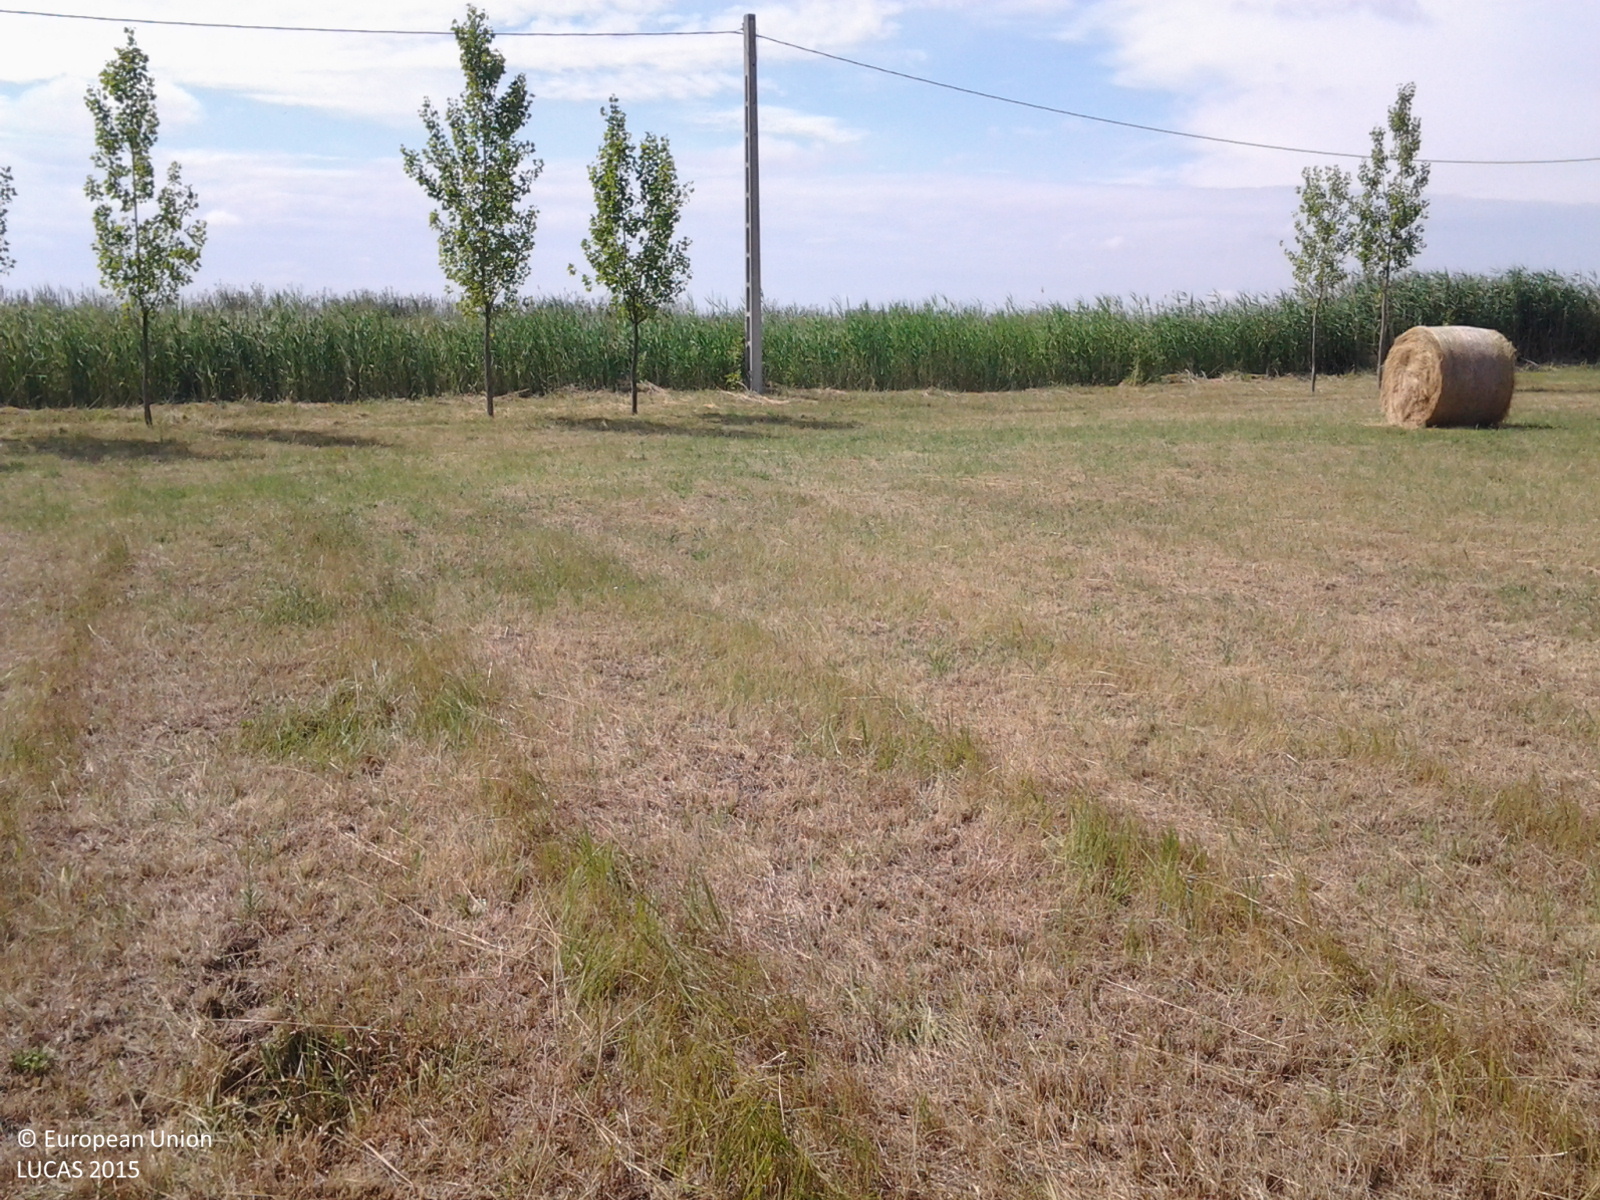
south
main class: Grassland
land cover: Grassland without tree/shrub cover
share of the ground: > 75 %
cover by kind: herbaceous plants 100 %
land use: Agriculture (excluding fallow land and kitchen gardens)
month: June
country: HU
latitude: 47.0824
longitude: 20.1545
